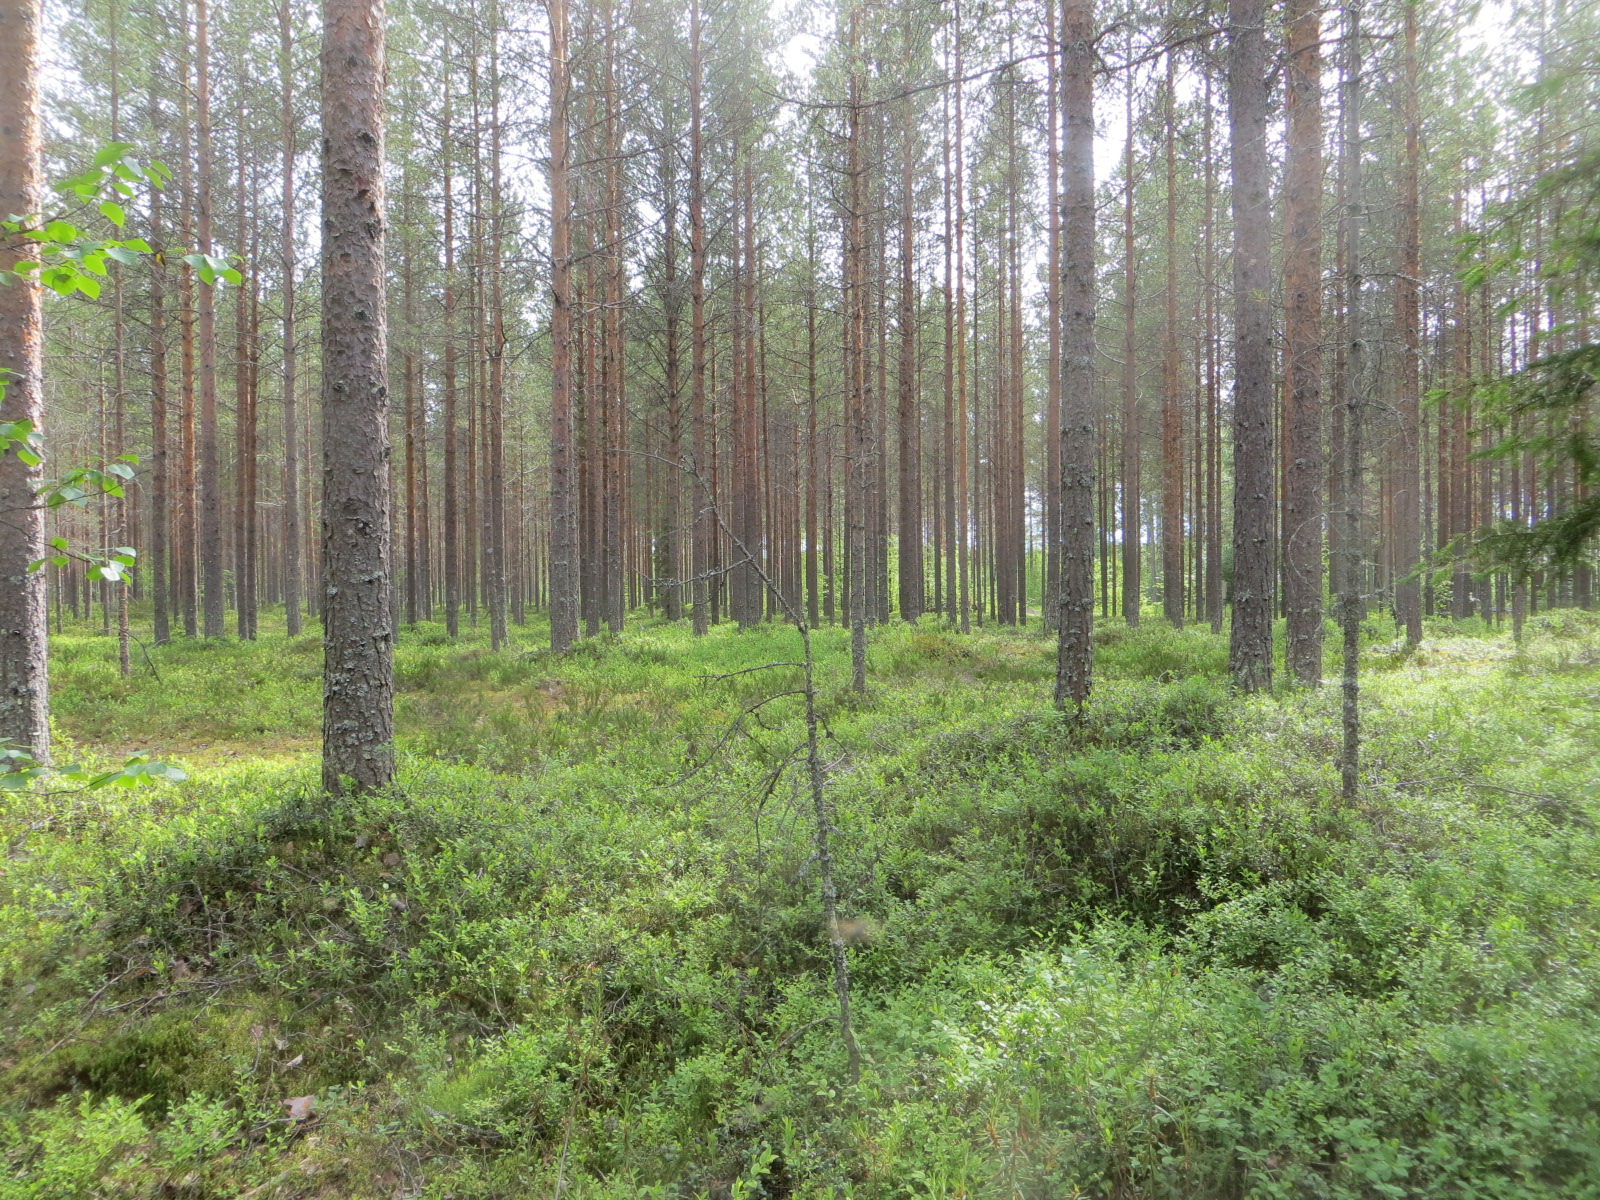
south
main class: Woodland
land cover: Pine dominated coniferous woodland
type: boreal forest
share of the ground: 50 - 75 %
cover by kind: coniferous forest trees 65 %, shrubs 30 %, broadleaved forest trees 5 %
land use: Forestry
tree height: > 5 m
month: July
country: FI
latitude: 65.3676
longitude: 25.8924
